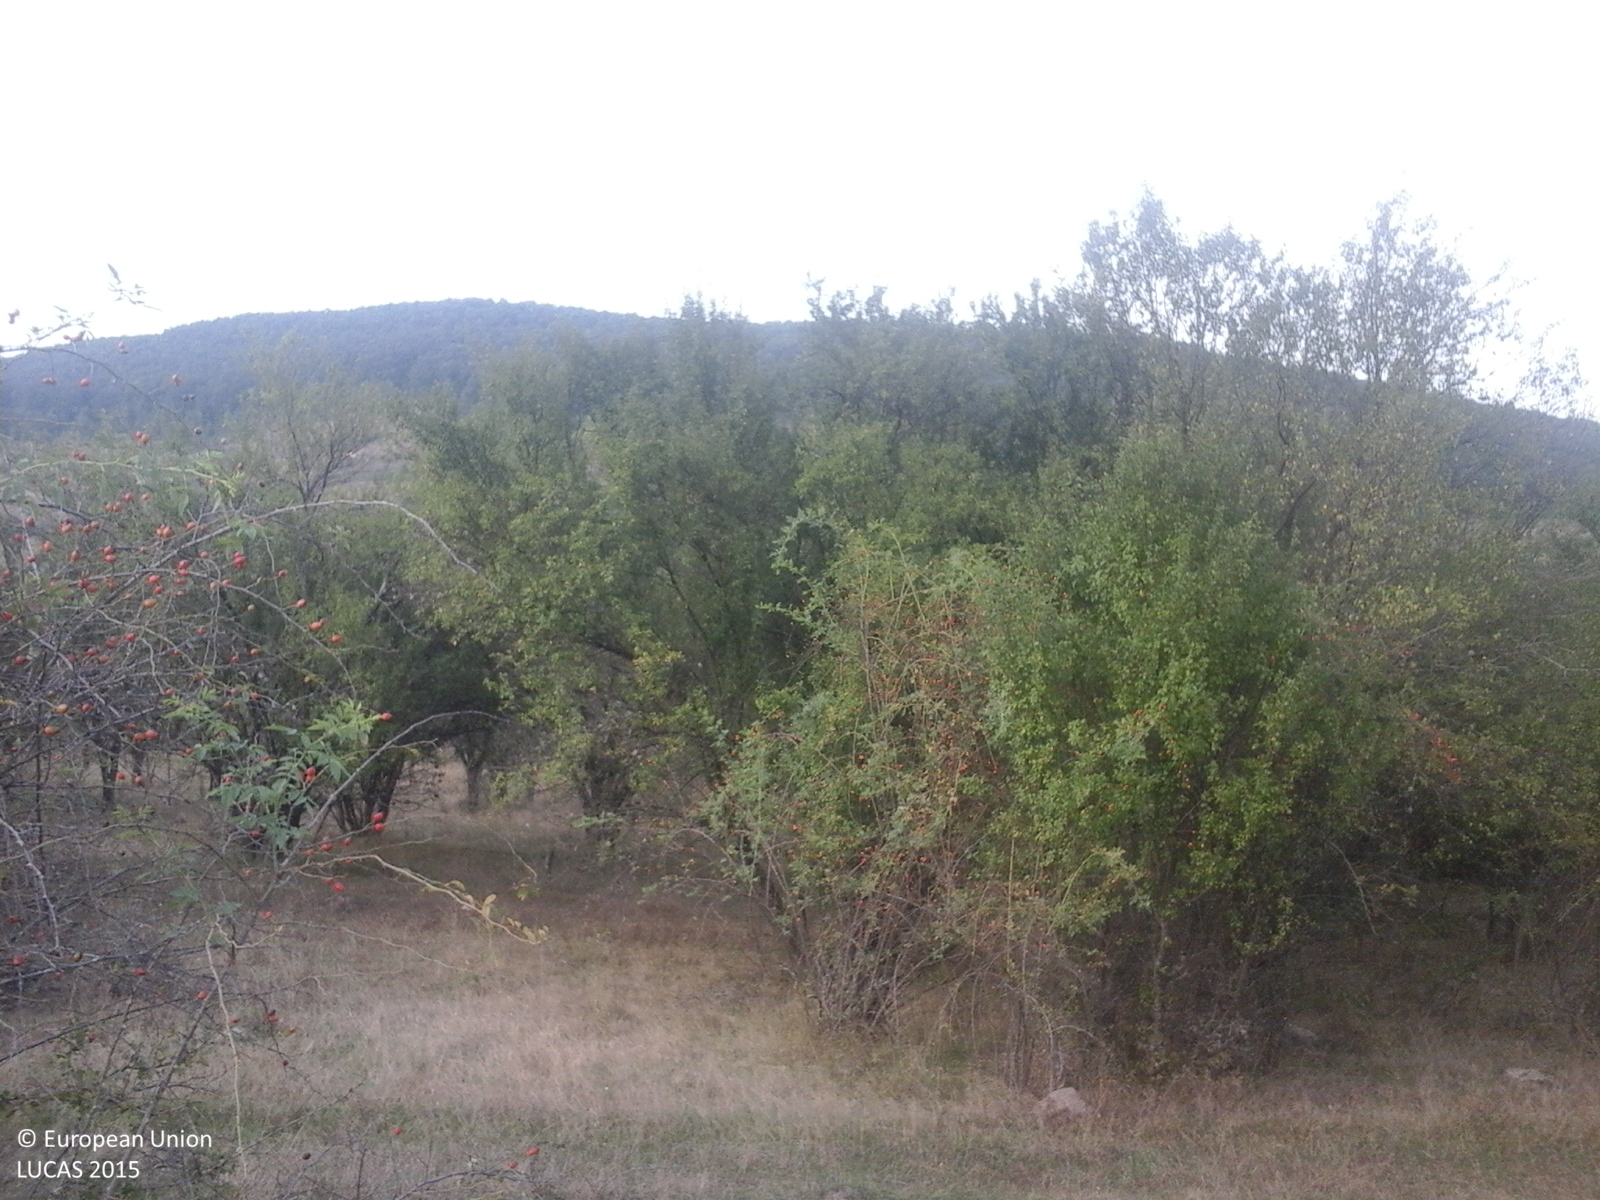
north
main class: Cropland
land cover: Other fruit trees and berries
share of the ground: > 75 %
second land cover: Grassland without tree/shrub cover
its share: > 75 %
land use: Agriculture (excluding fallow land and kitchen gardens)
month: September
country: RO
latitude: 47.0200
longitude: 23.2355
